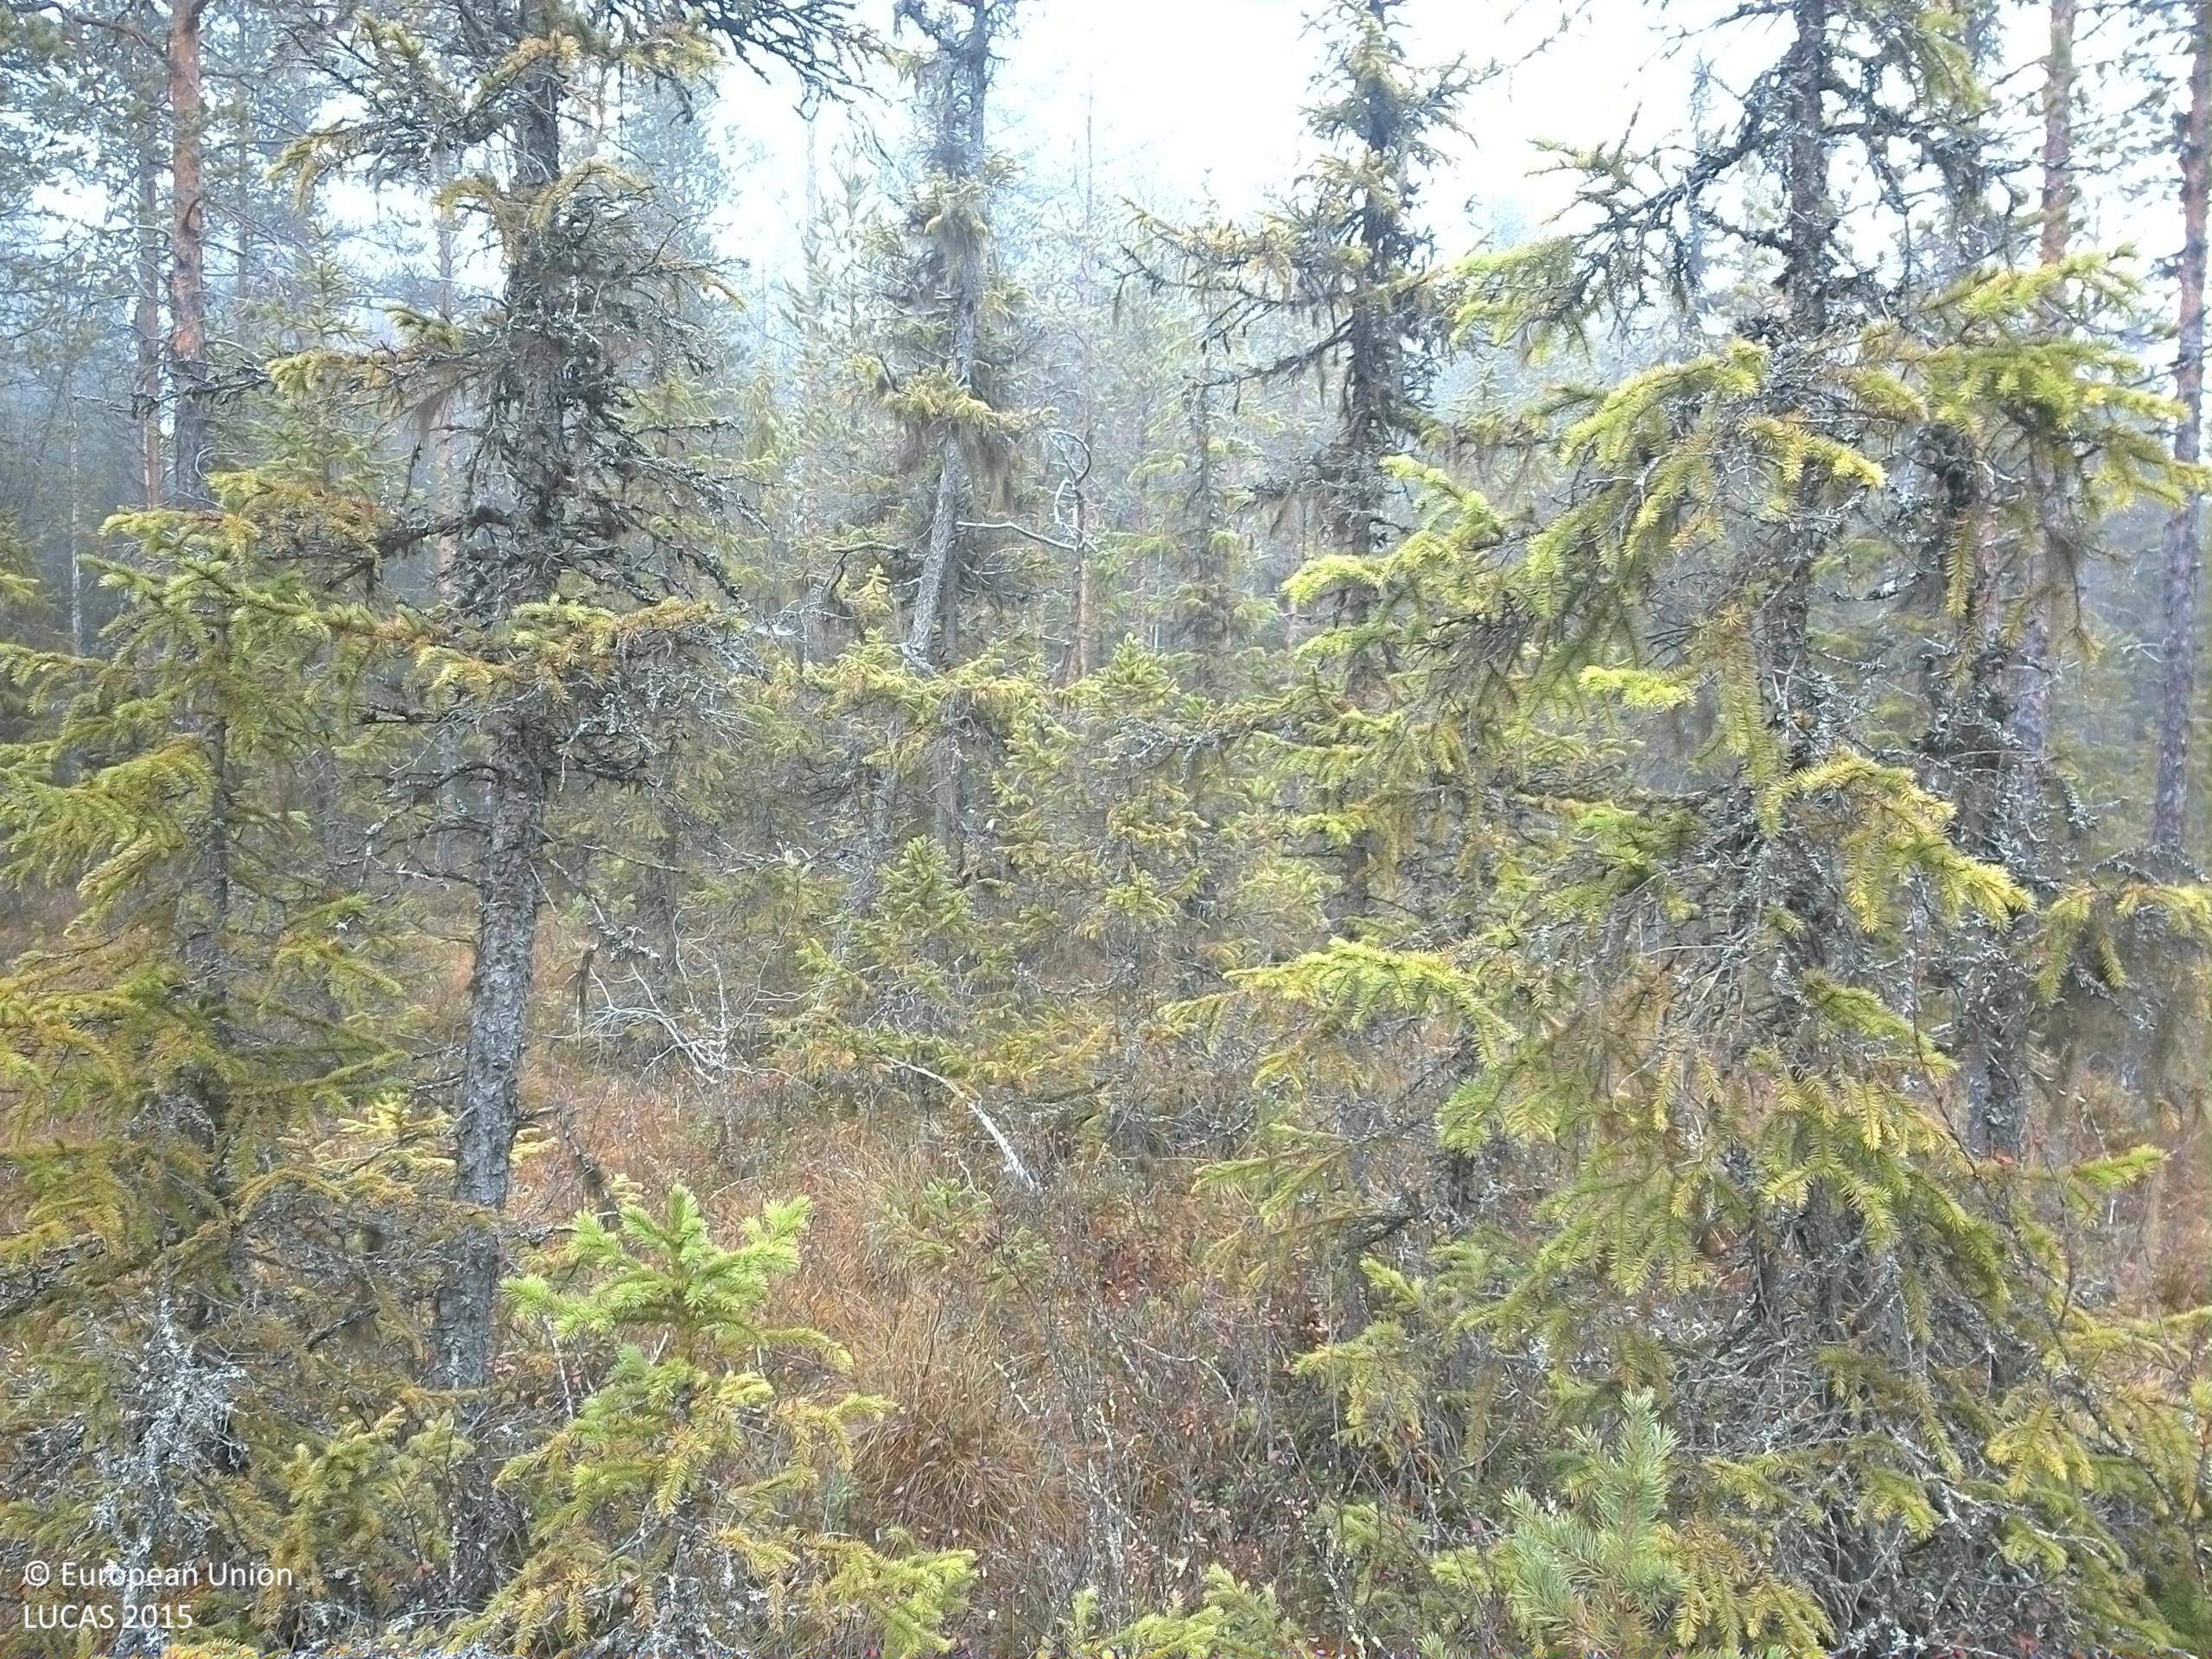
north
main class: Woodland
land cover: Pine dominated coniferous woodland
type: boreal forest
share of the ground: 25 - 50 %
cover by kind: coniferous forest trees 30 %, shrubs 25 %, lichens and mosses 25 %, herbaceous plants 20 %
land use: Forestry
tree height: > 5 m
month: October
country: SE
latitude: 64.0523
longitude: 16.3822
